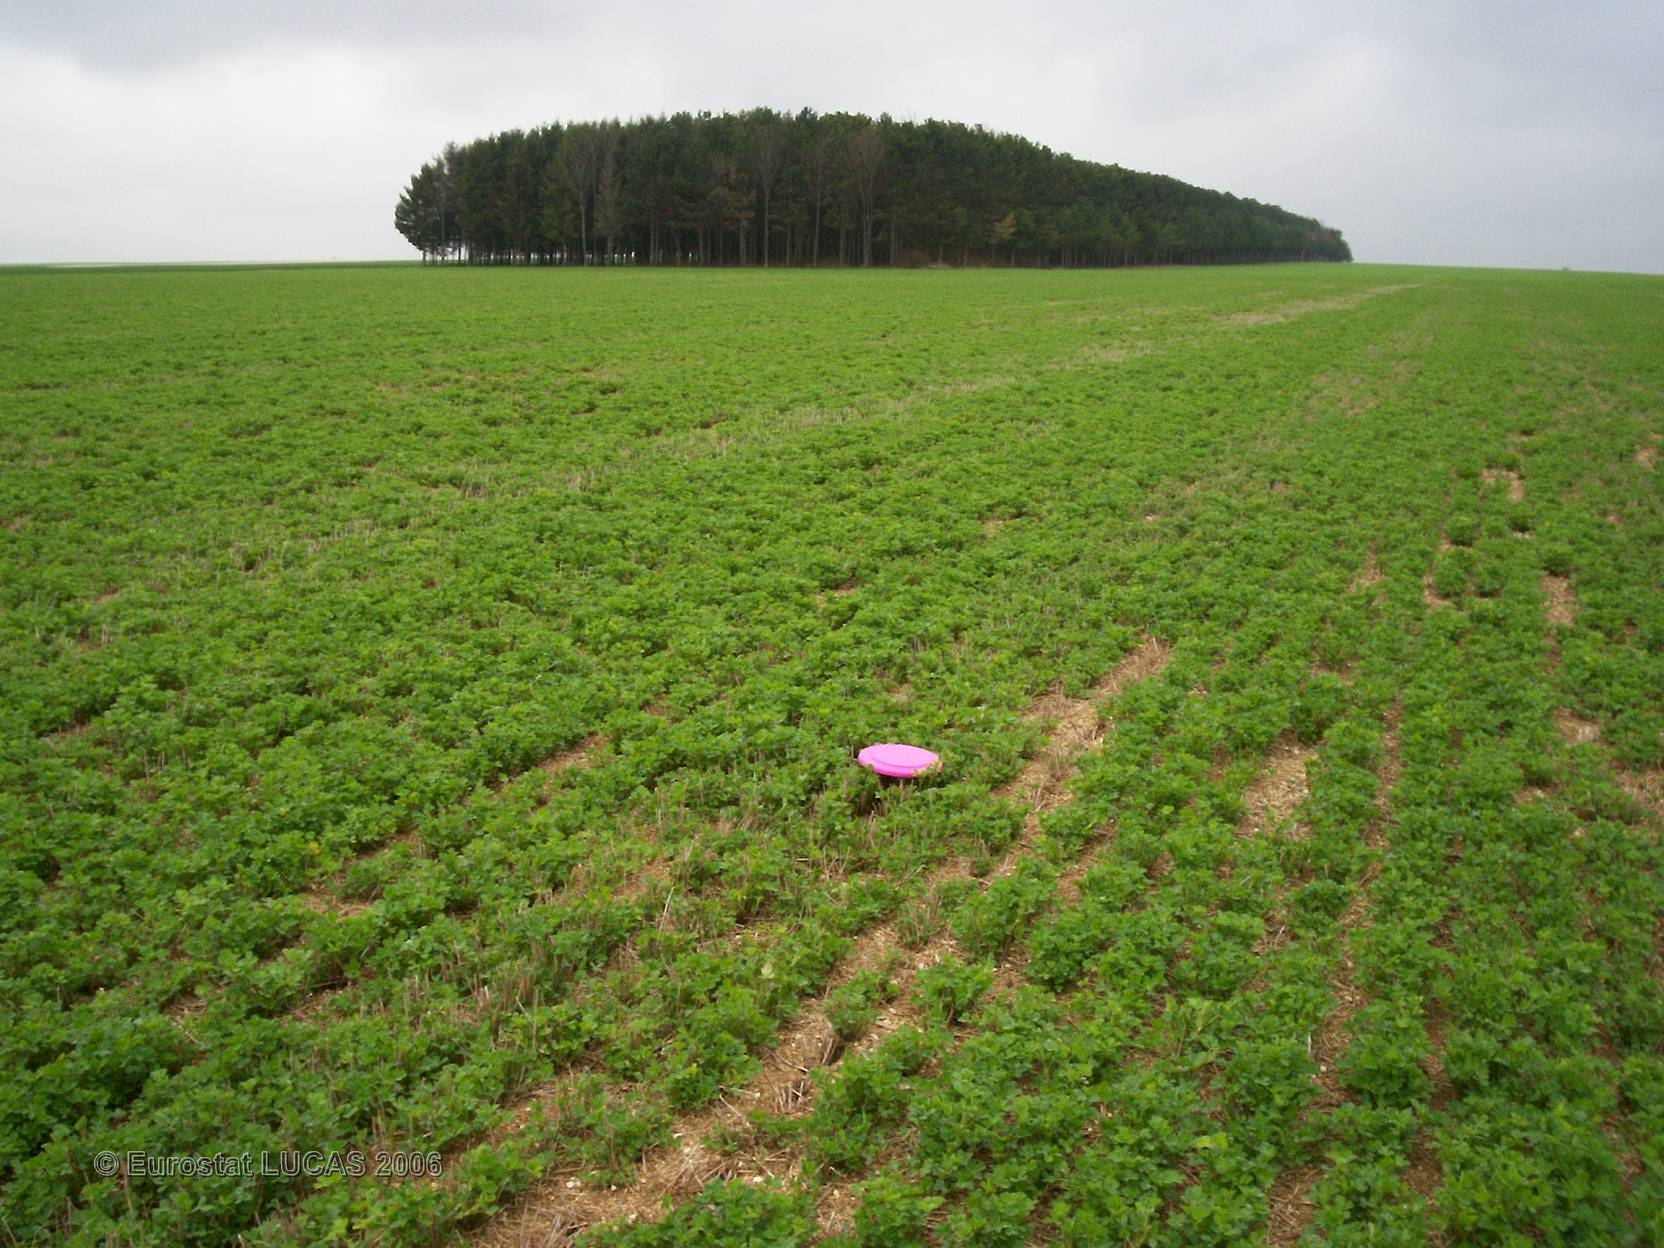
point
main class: Cropland
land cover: Lucerne
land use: Agriculture (excluding fallow land and kitchen gardens)
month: April
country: FR
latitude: 49.2630
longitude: 4.5963
